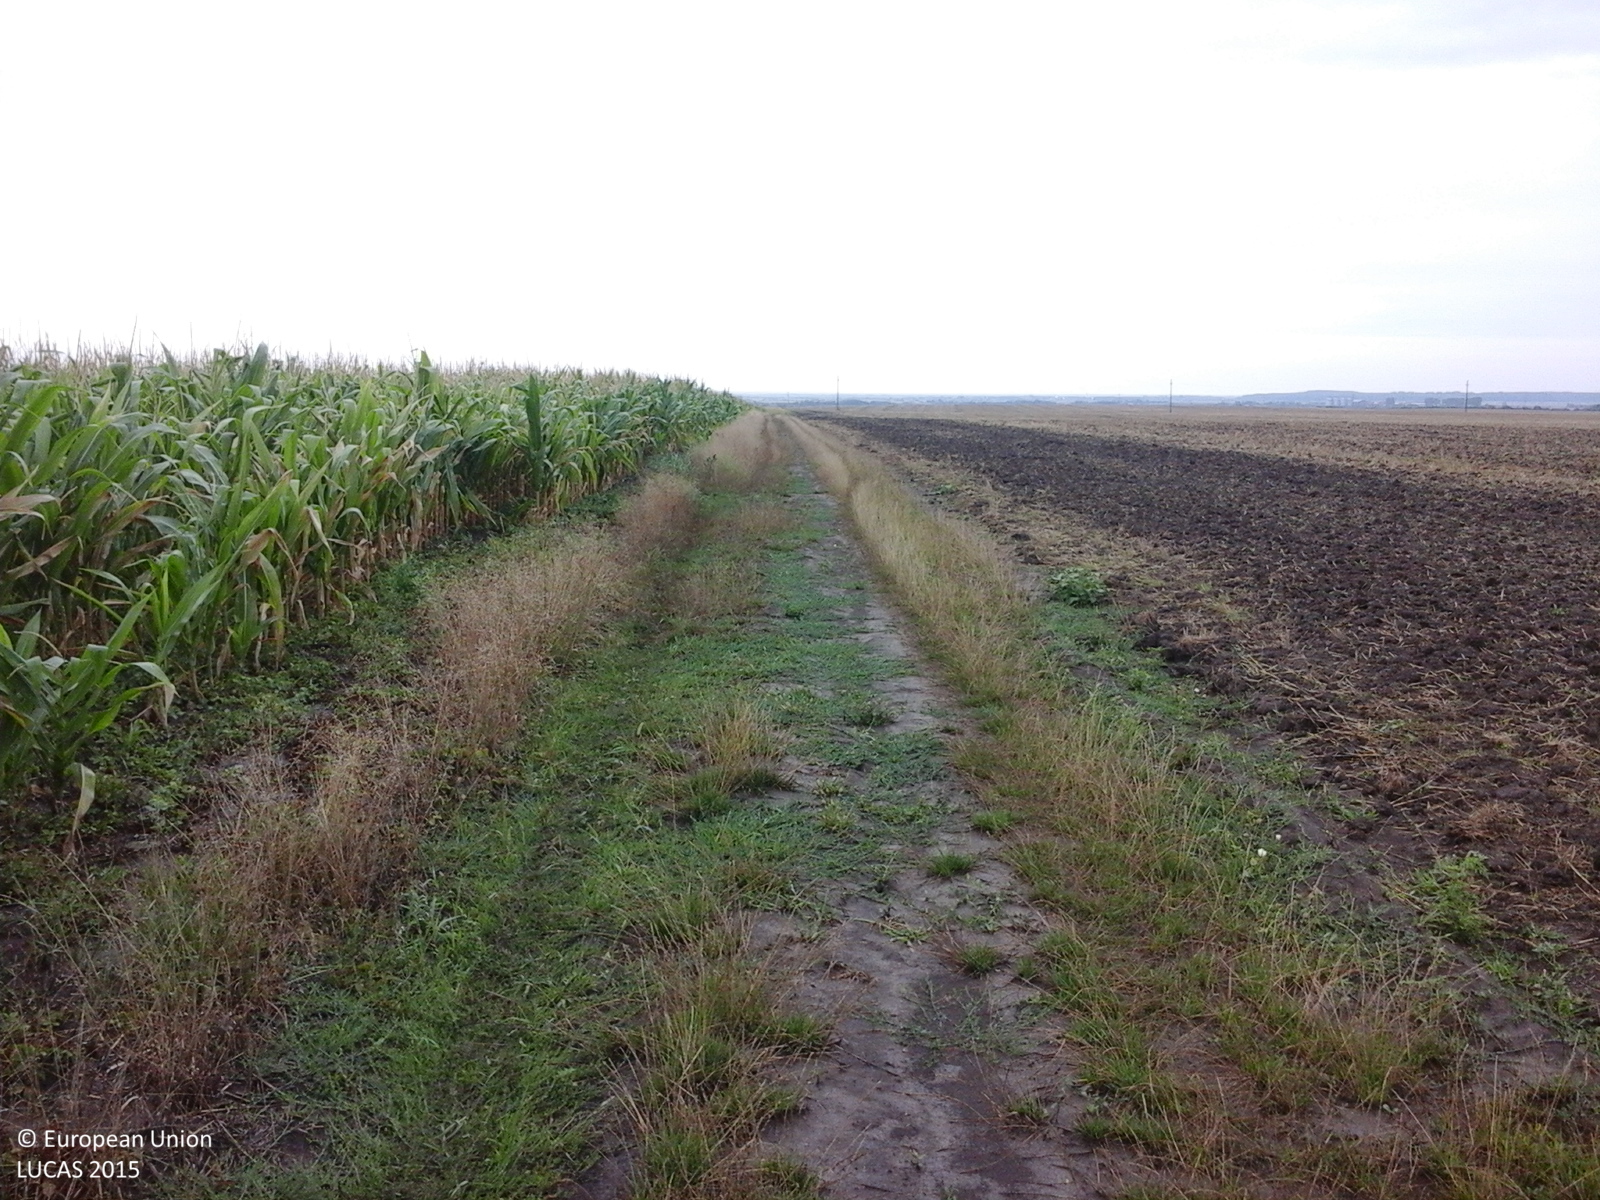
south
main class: Cropland
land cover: Maize
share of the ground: > 75 %
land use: Agriculture (excluding fallow land and kitchen gardens)
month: August
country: RO
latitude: 45.4516
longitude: 21.3723
